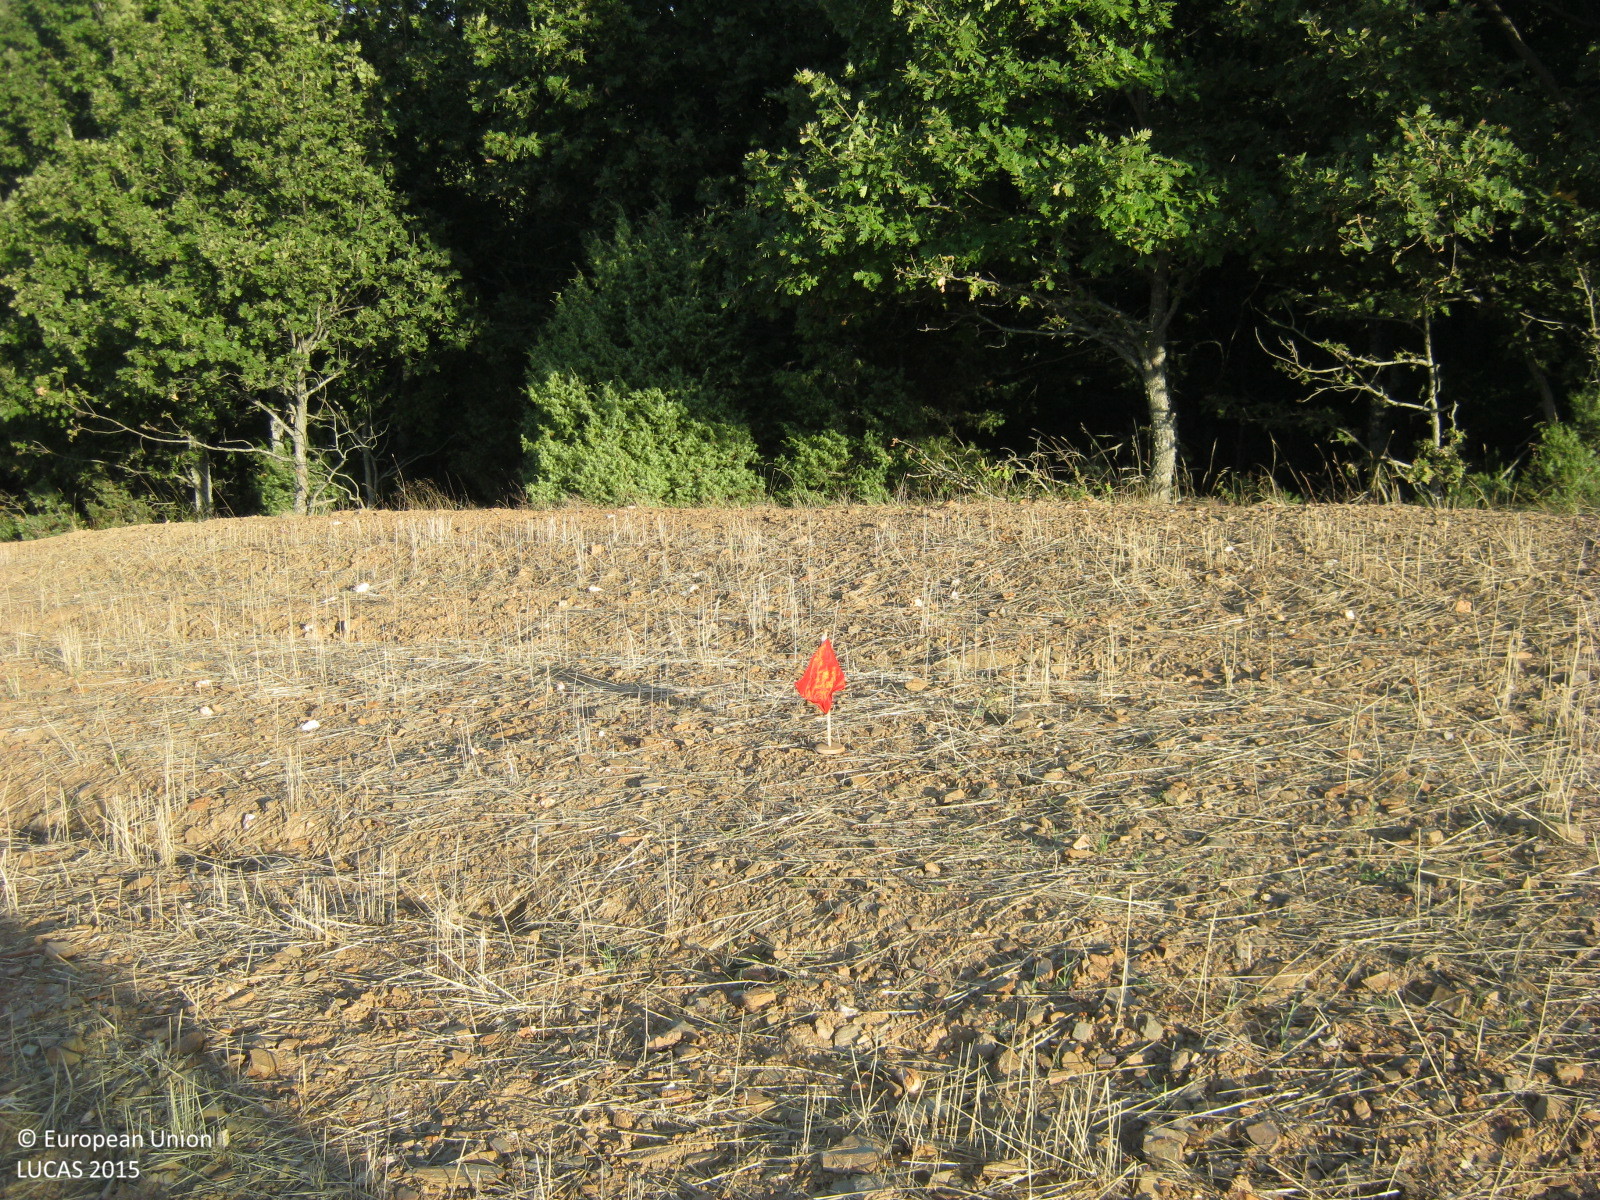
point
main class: Cropland
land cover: Durum wheat
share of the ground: > 75 %
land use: Agriculture (excluding fallow land and kitchen gardens)
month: September
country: GR
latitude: 40.4496
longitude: 23.3453
